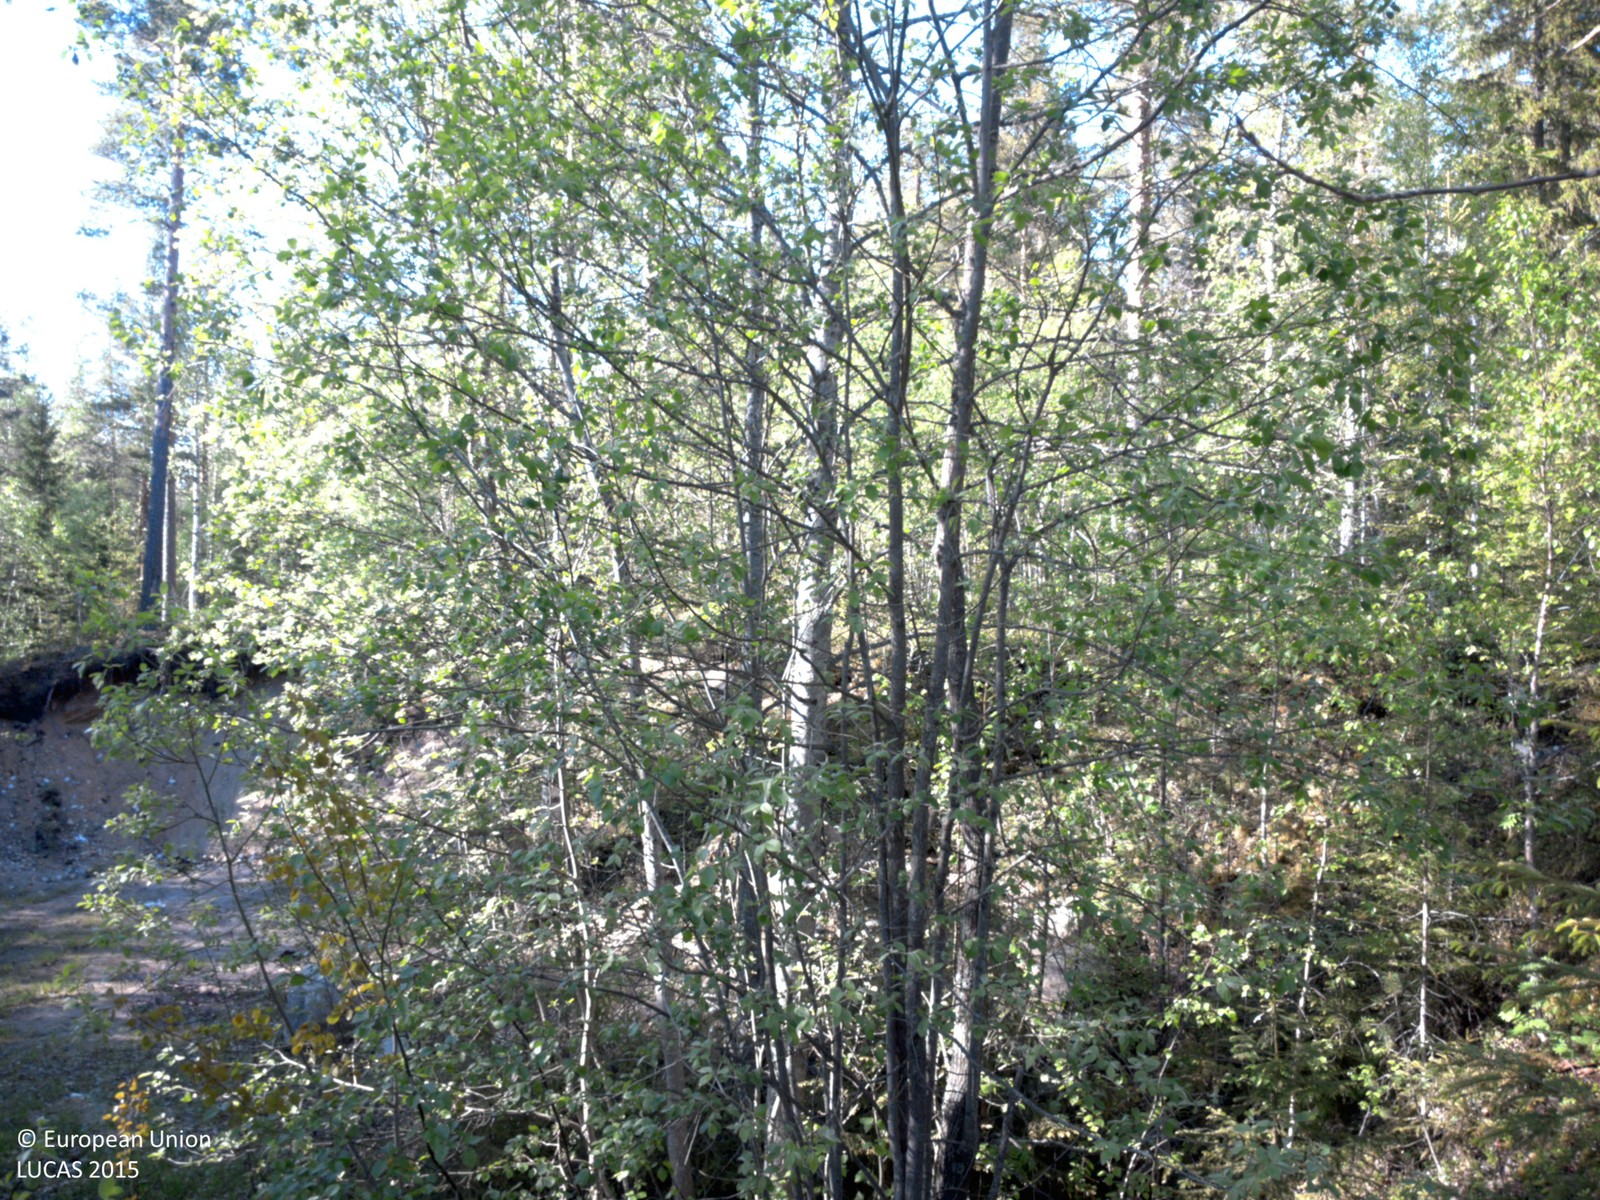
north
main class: Woodland
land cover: Other mixed woodland
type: boreal forest
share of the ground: 50 - 75 %
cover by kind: shrubs 45 %, coniferous forest trees 30 %, broadleaved forest trees 25 %
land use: Semi-natural and natural areas not in use
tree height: > 5 m
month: June
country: SE
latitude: 63.9847
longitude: 20.0945
